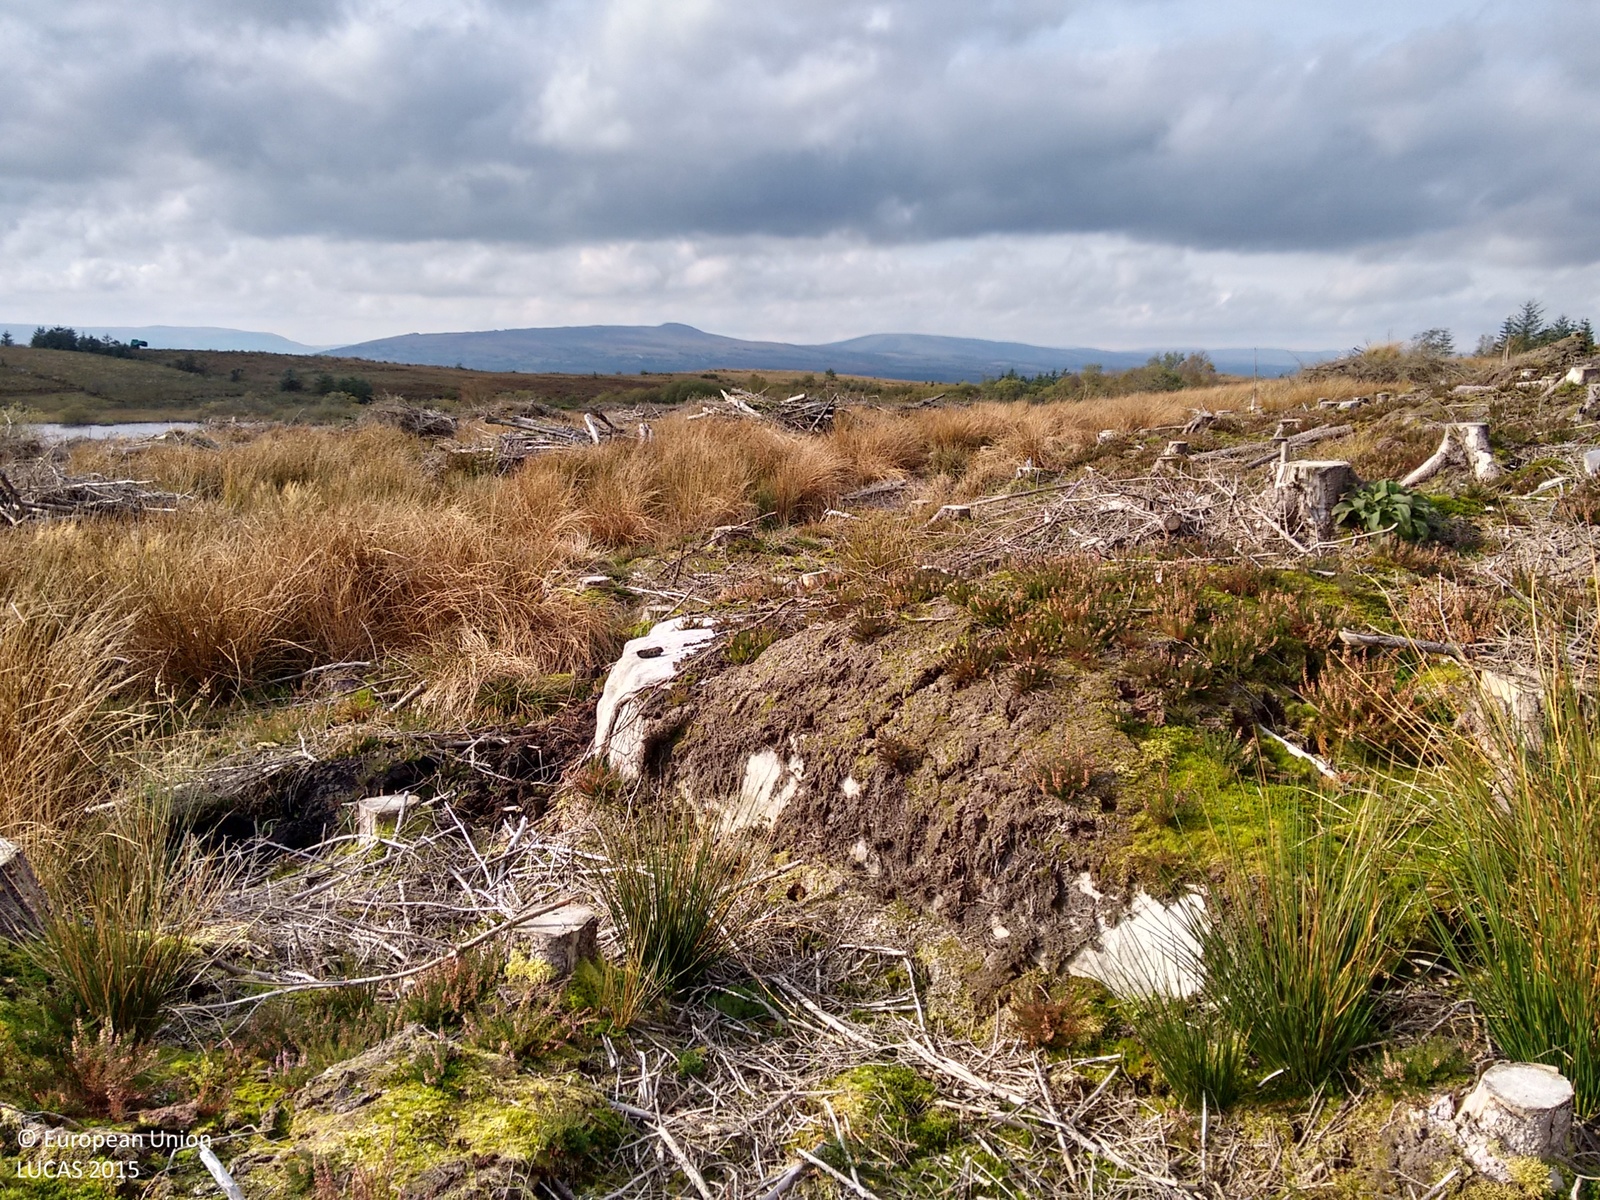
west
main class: Grassland
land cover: Grassland without tree/shrub cover
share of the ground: > 75 %
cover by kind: herbaceous plants 55 %, unconsolidated bare surface 25 %, lichens and mosses 20 %
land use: Forestry
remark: Clear cut
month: October
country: GB
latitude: 54.3222
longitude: -7.8968
